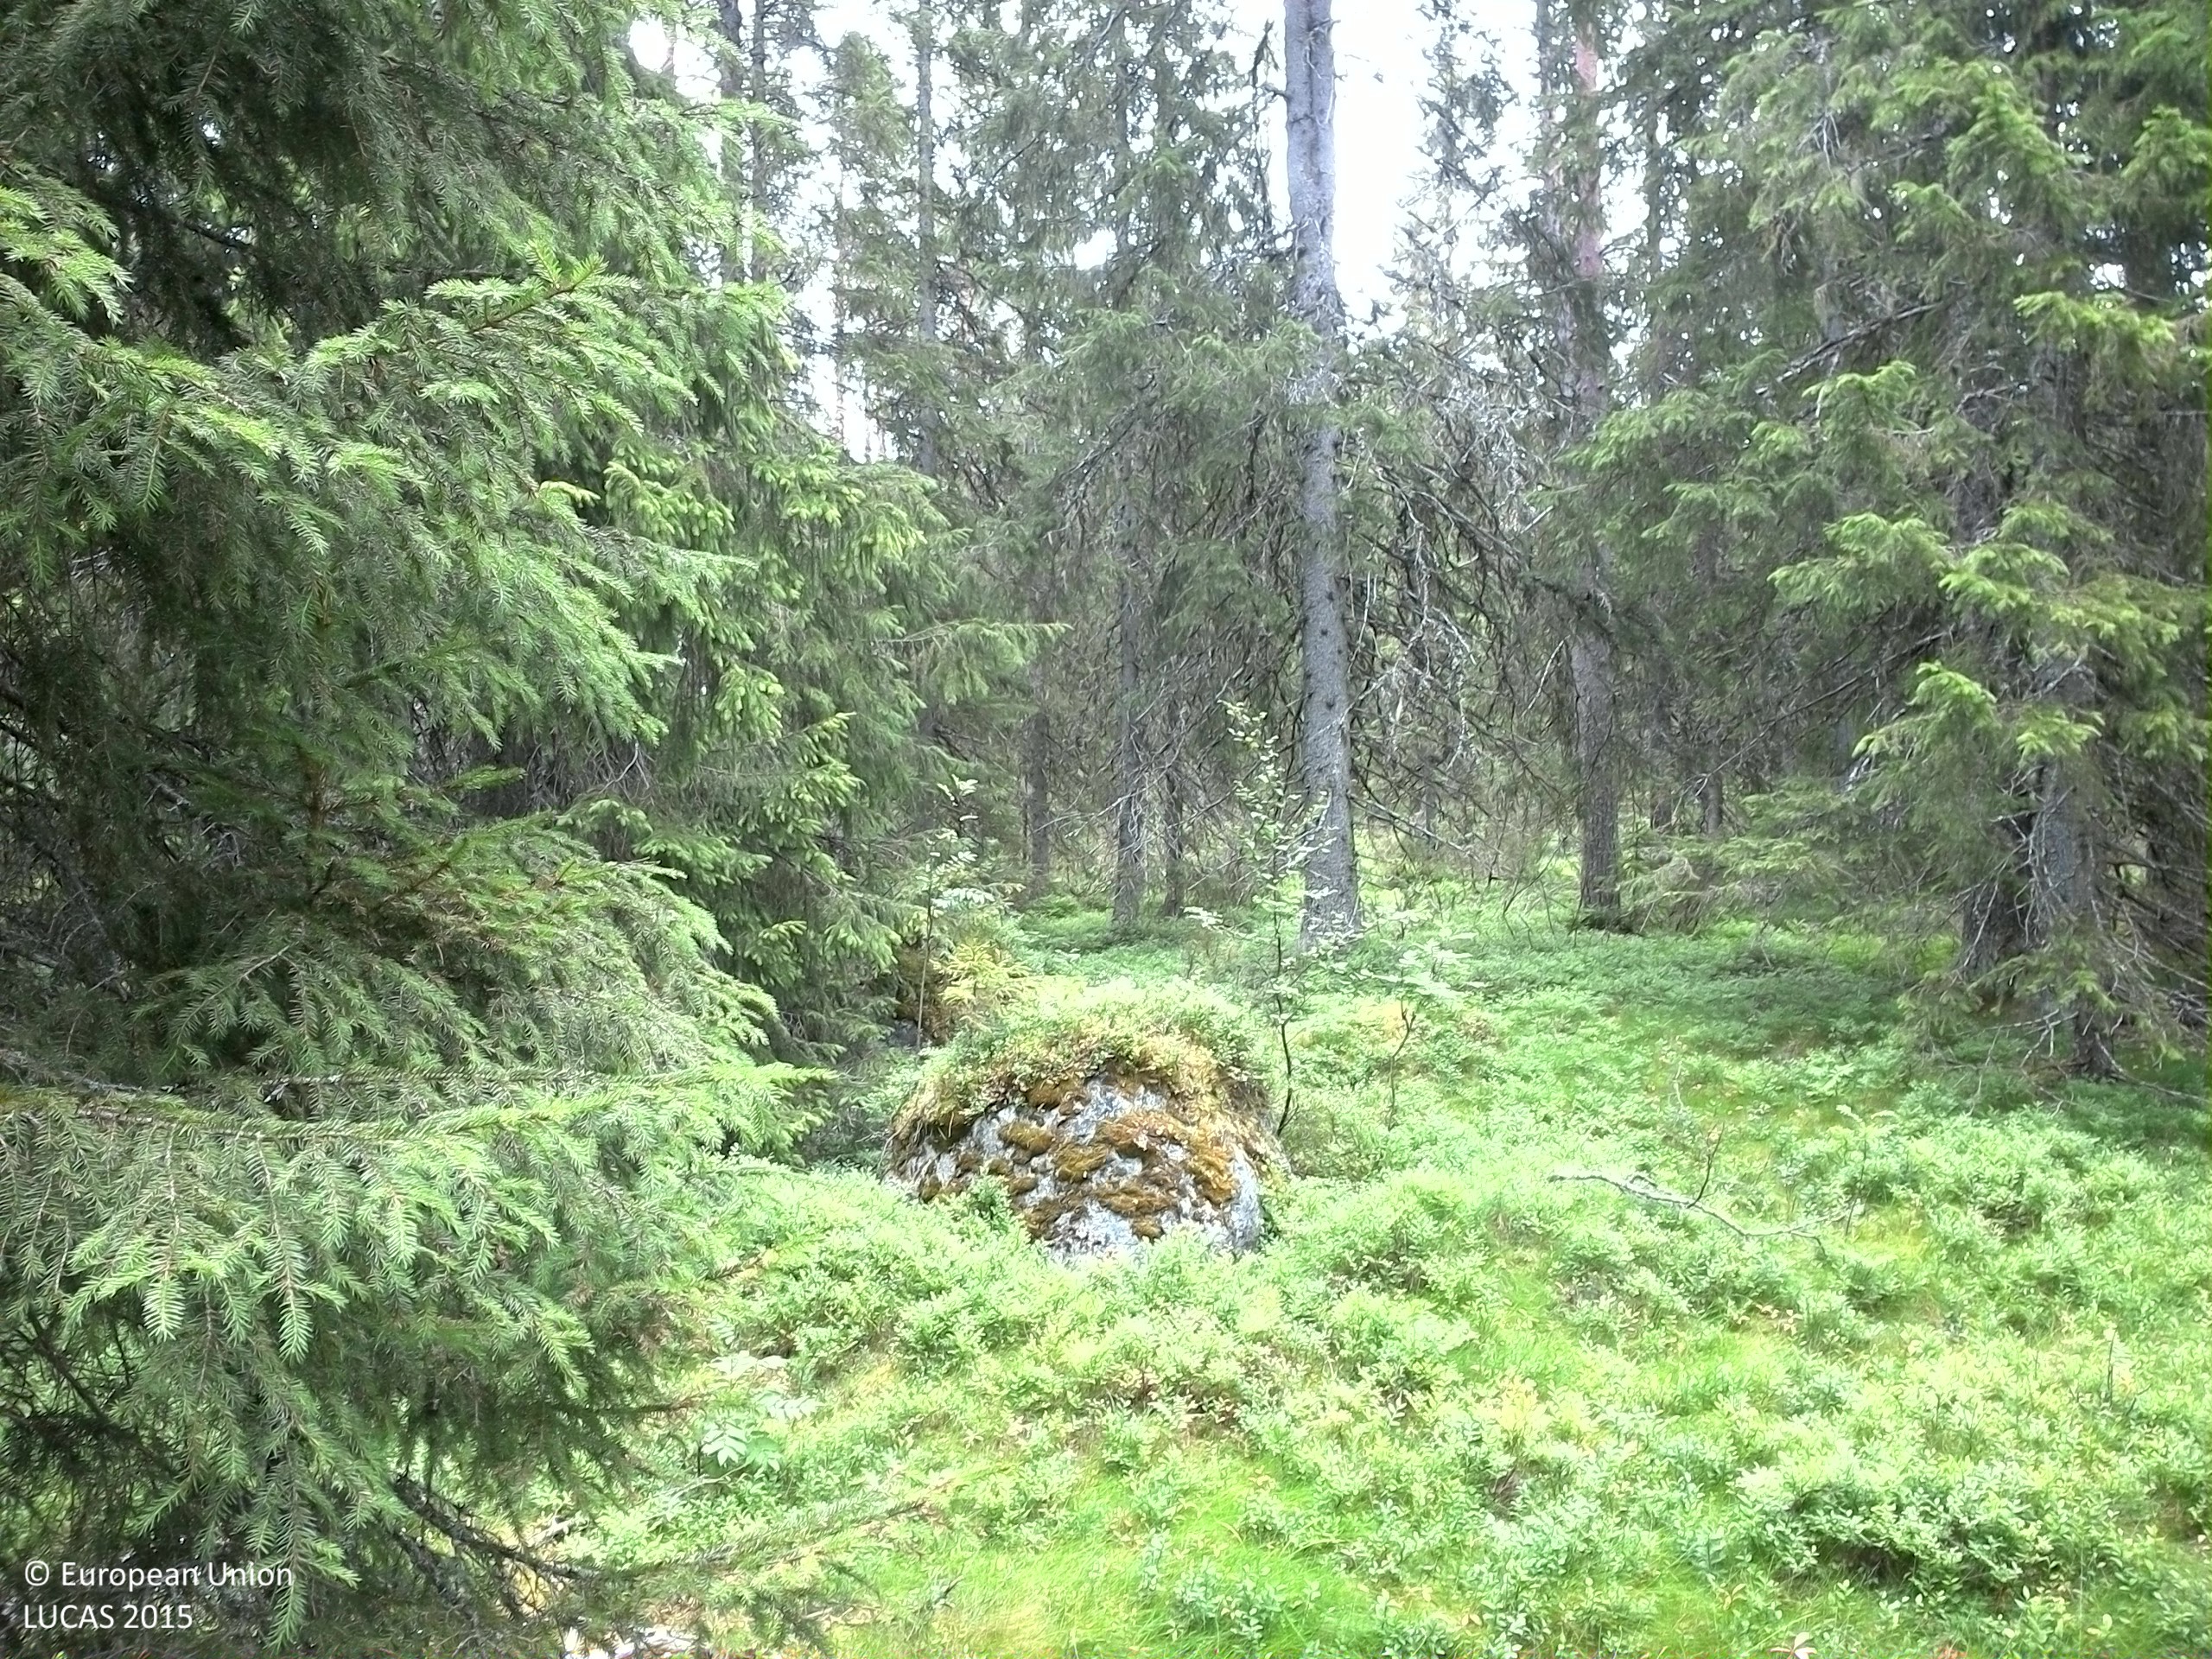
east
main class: Woodland
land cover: Spruce dominated coniferous woodland
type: boreal forest
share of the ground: 50 - 75 %
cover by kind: coniferous forest trees 55 %, shrubs 30 %, herbaceous plants 10 %, broadleaved forest trees 5 %
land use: Forestry
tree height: > 5 m
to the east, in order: Spruce dominated coniferous woodland; Pine dominated mixed woodland; Pine dominated coniferous woodland; Pine dominated mixed woodland; Pine dominated coniferous woodland
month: August
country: SE
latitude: 63.8309
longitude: 18.0408
